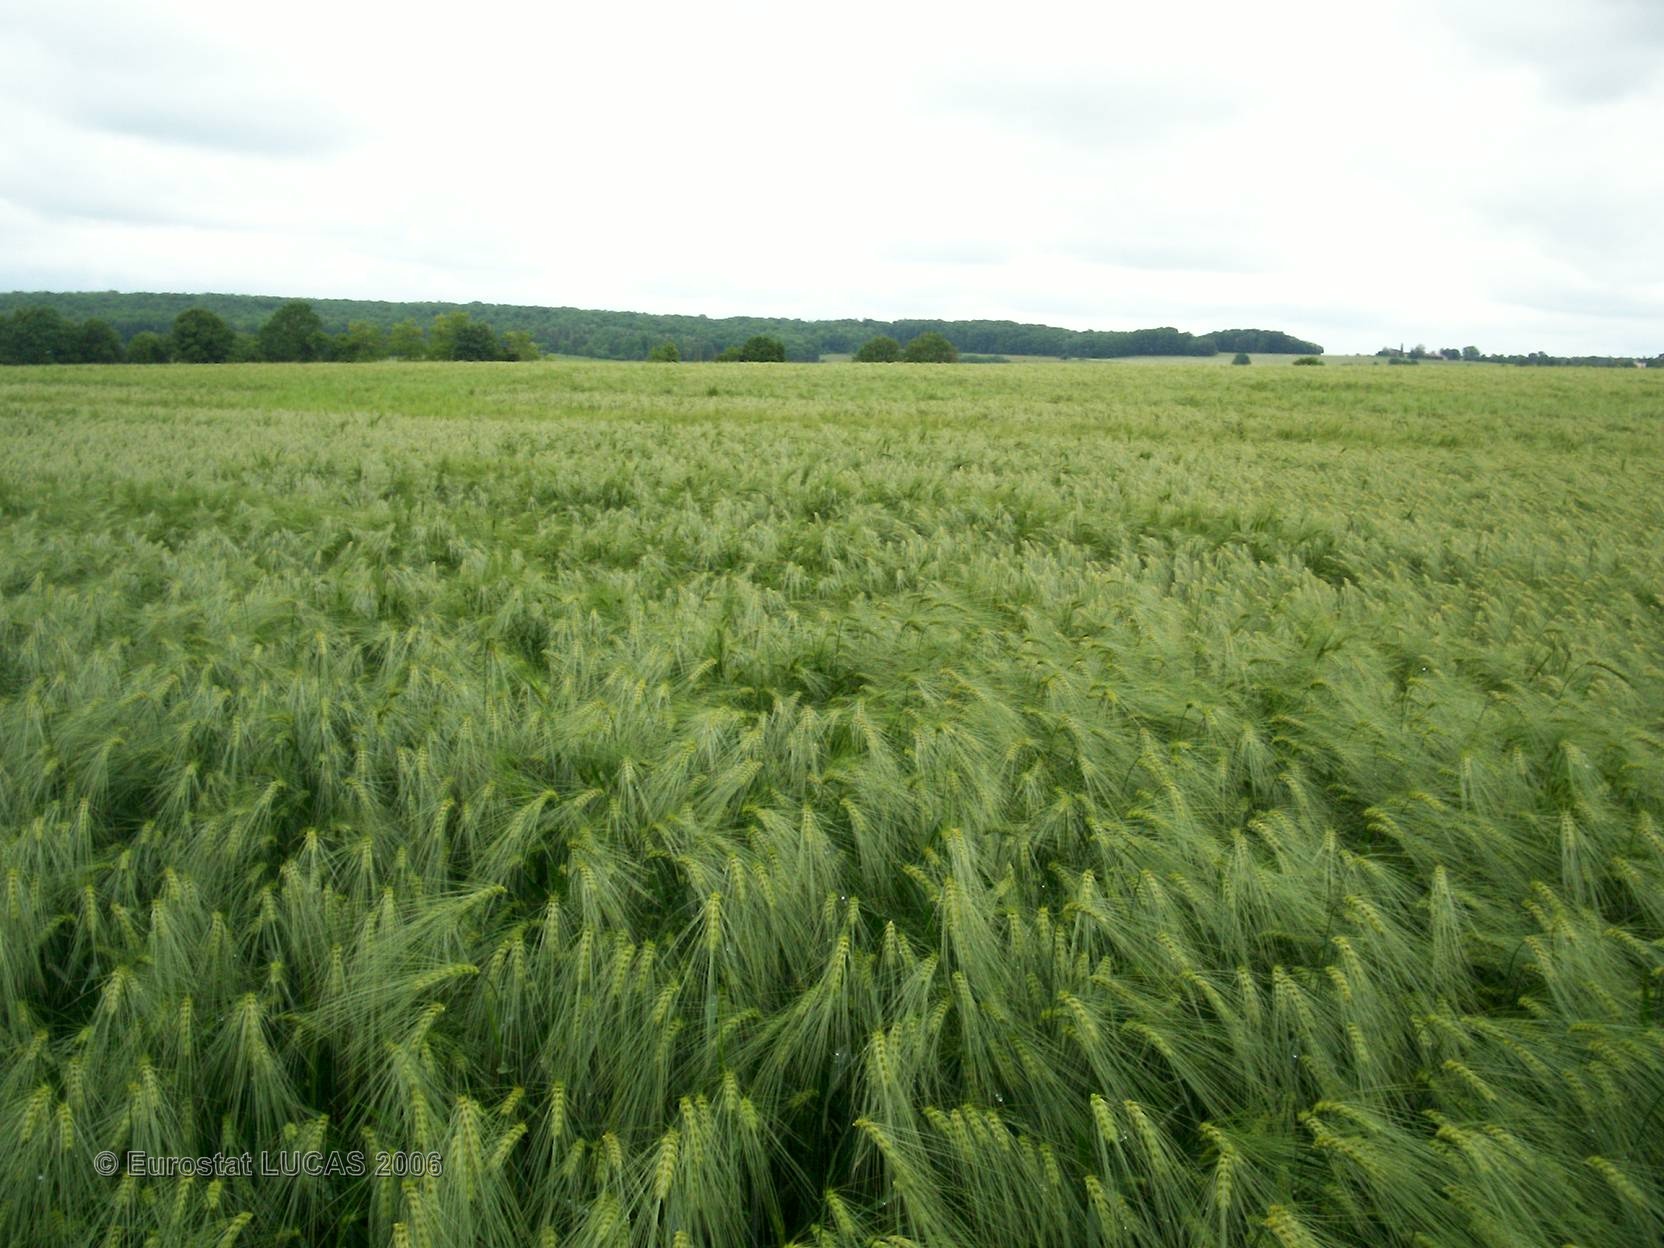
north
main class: Cropland
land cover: Barley
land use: Agriculture (excluding fallow land and kitchen gardens)
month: May
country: FR
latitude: 48.2494
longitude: 4.5164
